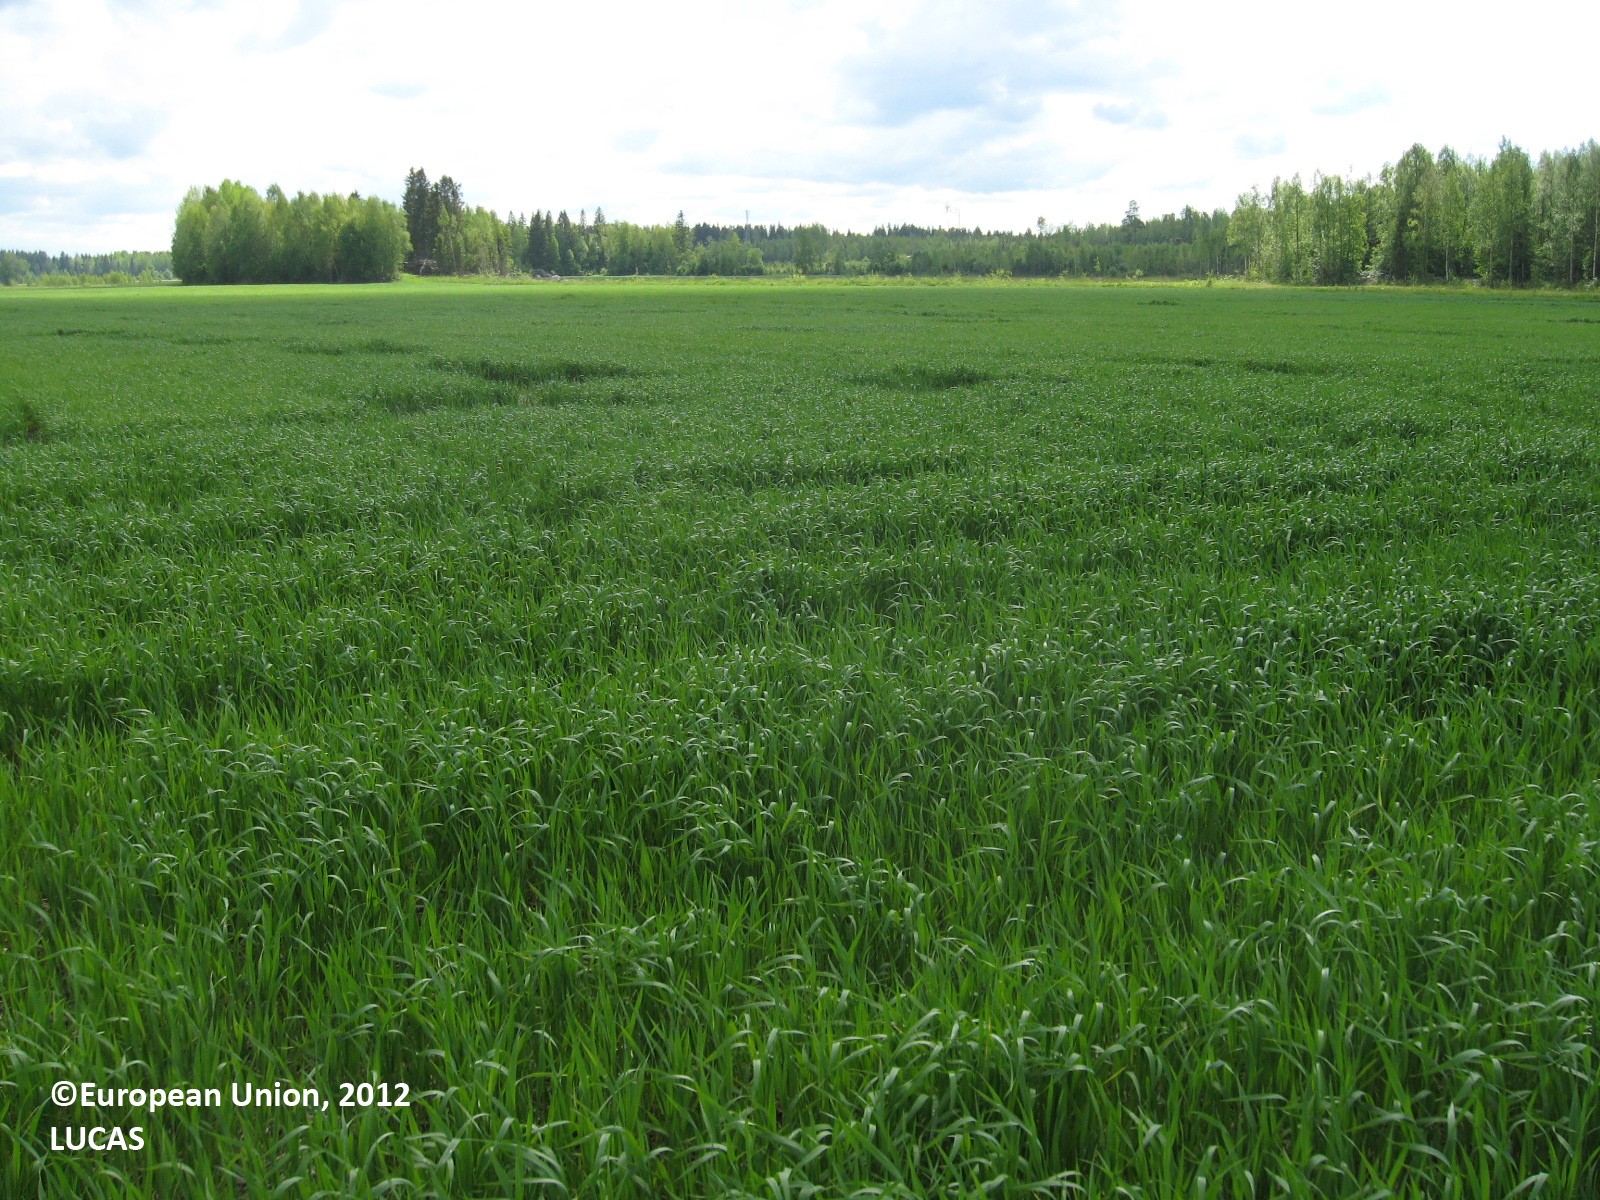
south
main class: Cropland
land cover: Triticale
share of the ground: > 75 %
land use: Agriculture (excluding fallow land and kitchen gardens)
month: June
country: FI
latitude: 63.0770
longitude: 21.8209
